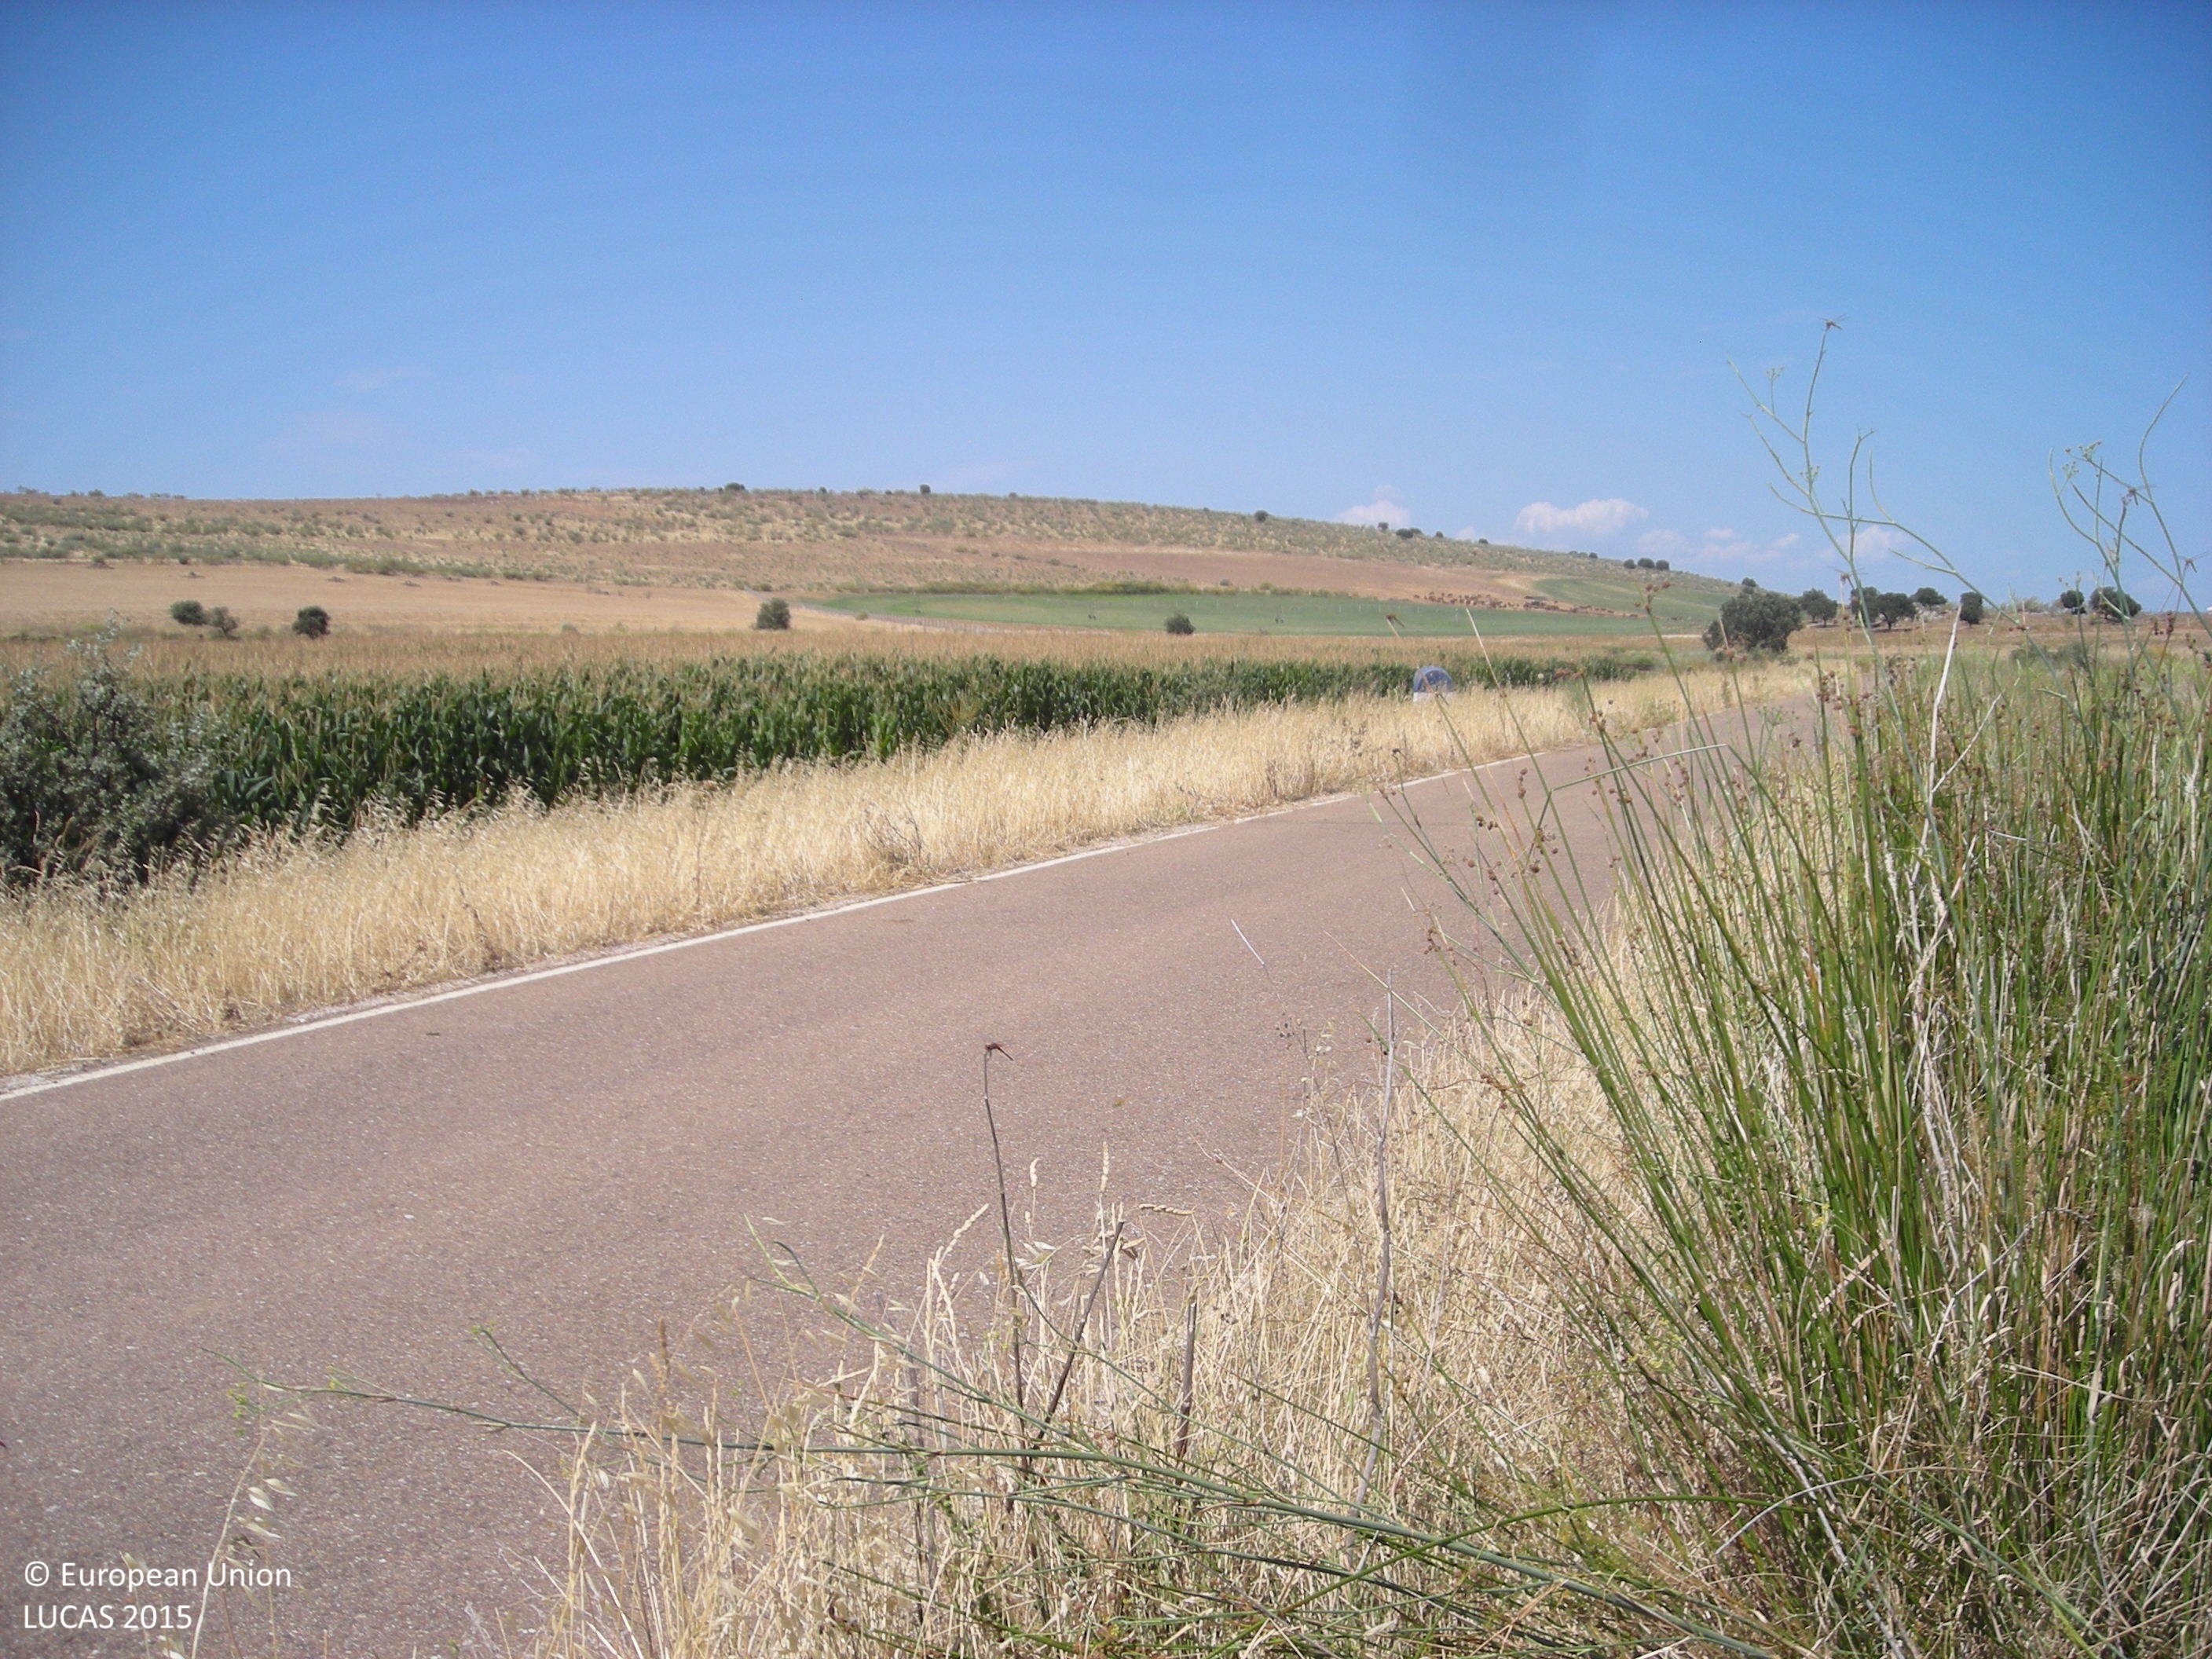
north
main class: Grassland
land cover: Grassland without tree/shrub cover
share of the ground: > 75 %
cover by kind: herbaceous plants 100 %
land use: Agriculture (excluding fallow land and kitchen gardens)
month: July
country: ES
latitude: 38.9900
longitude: -5.9491
